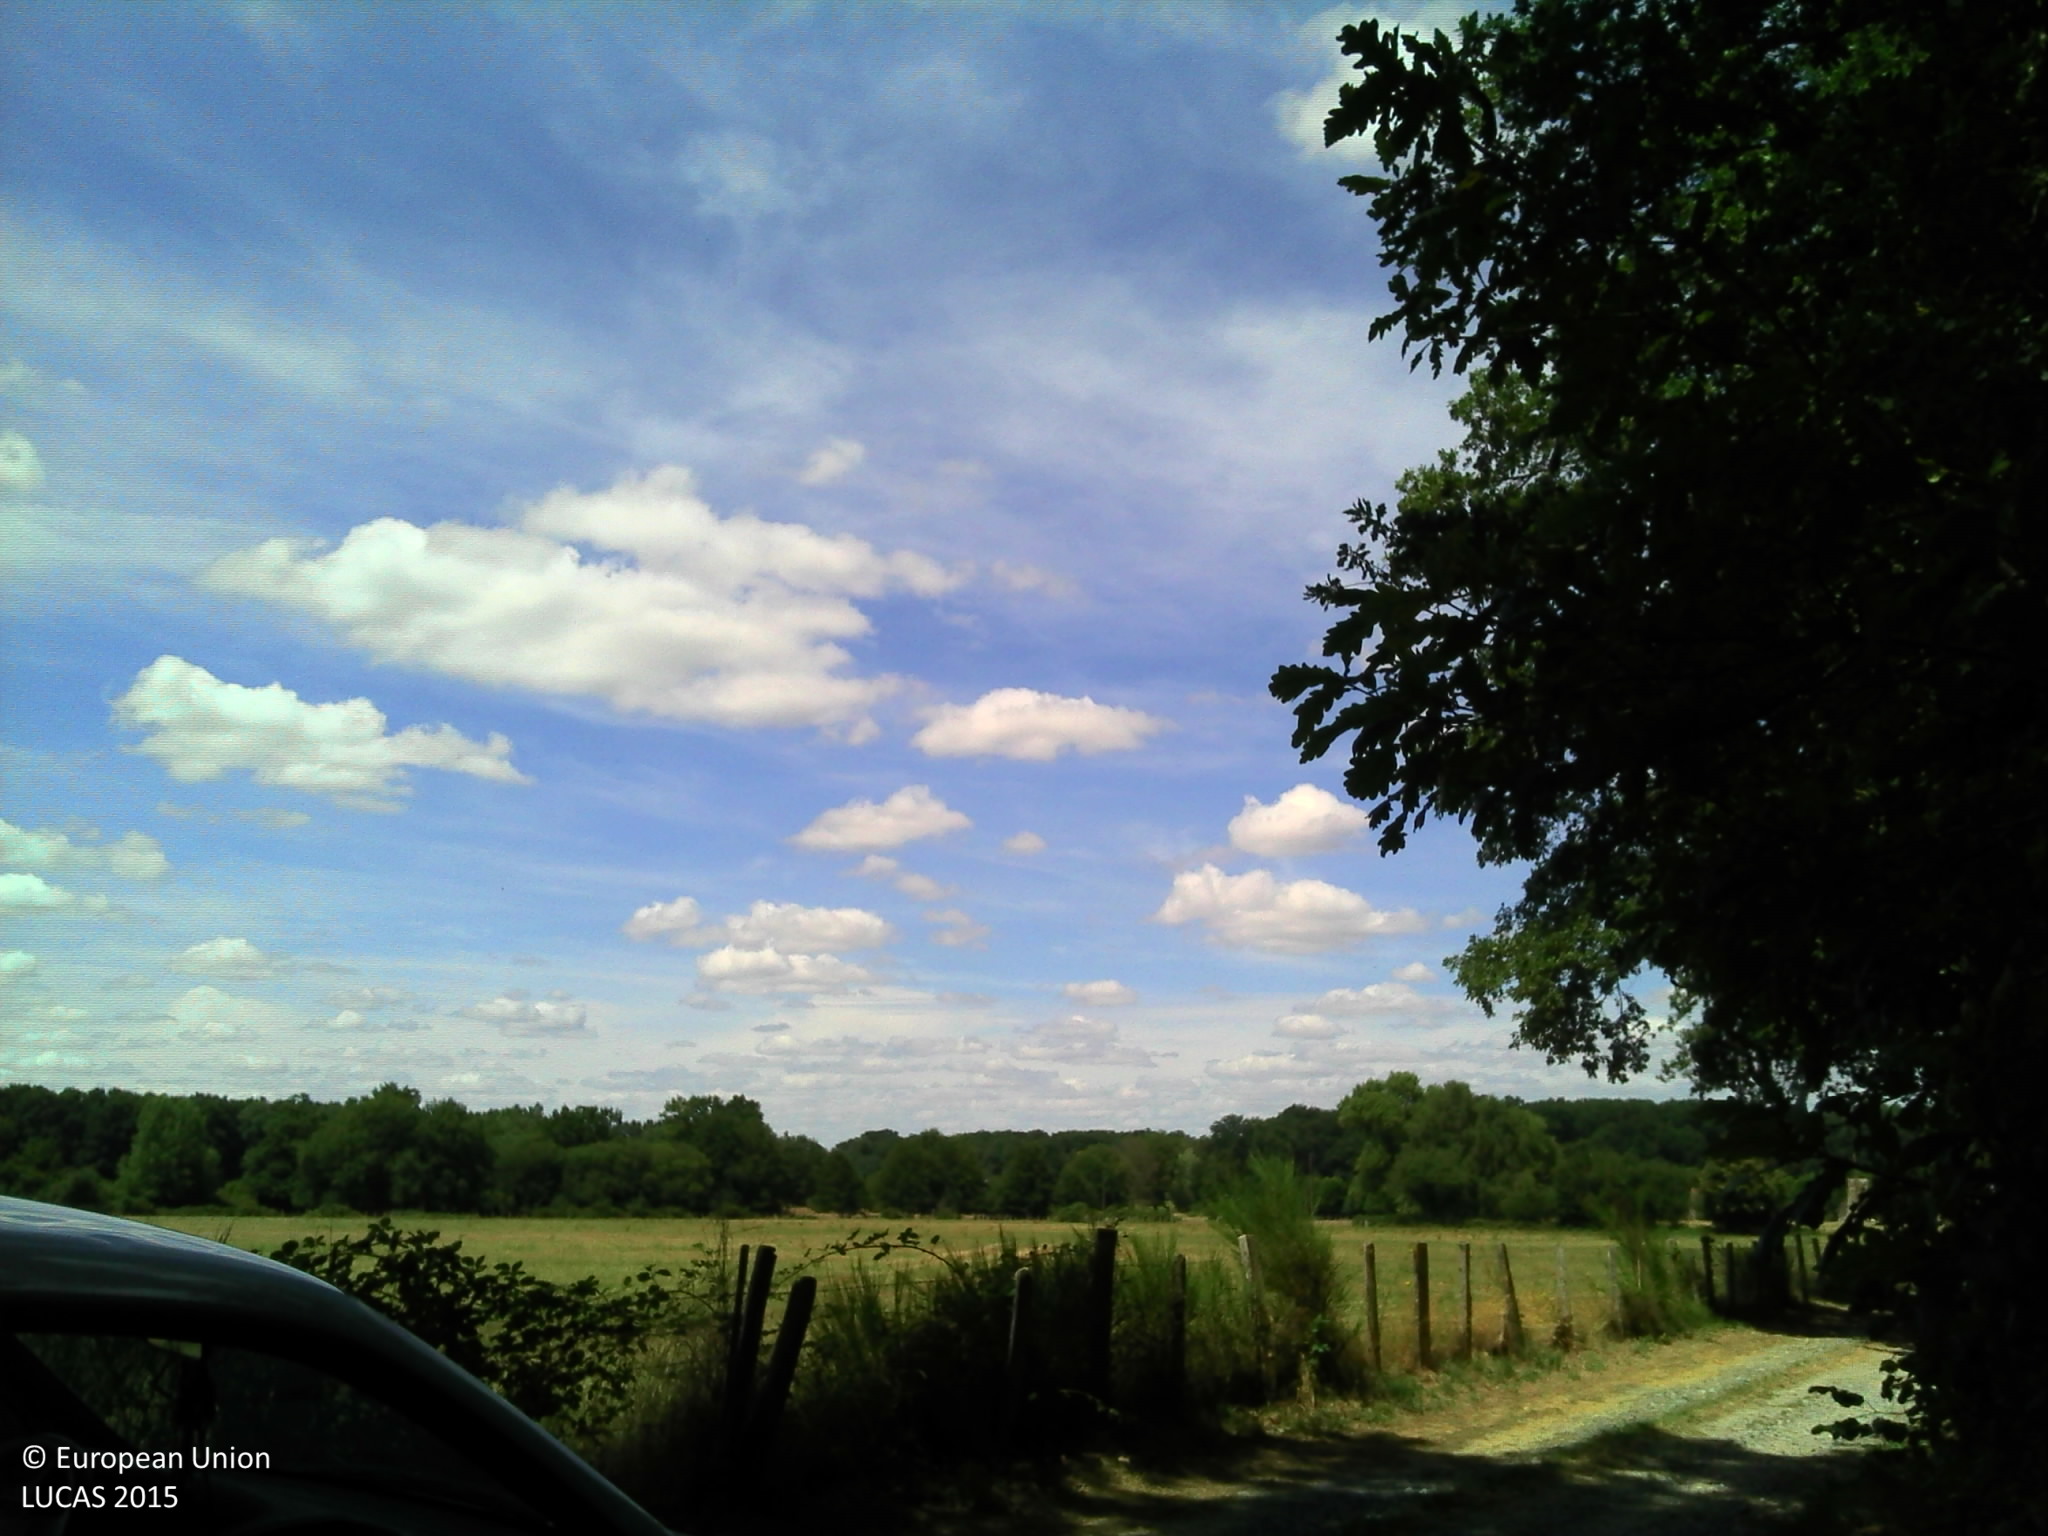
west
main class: Woodland
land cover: Broadleaved woodland
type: acidophilous oak and oak-birch forest
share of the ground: > 75 %
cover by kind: broadleaved forest trees 50 %, shrubs 30 %, herbaceous plants 20 %
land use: Forestry
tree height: > 5 m
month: July
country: FR
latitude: 48.0542
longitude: 0.5721
